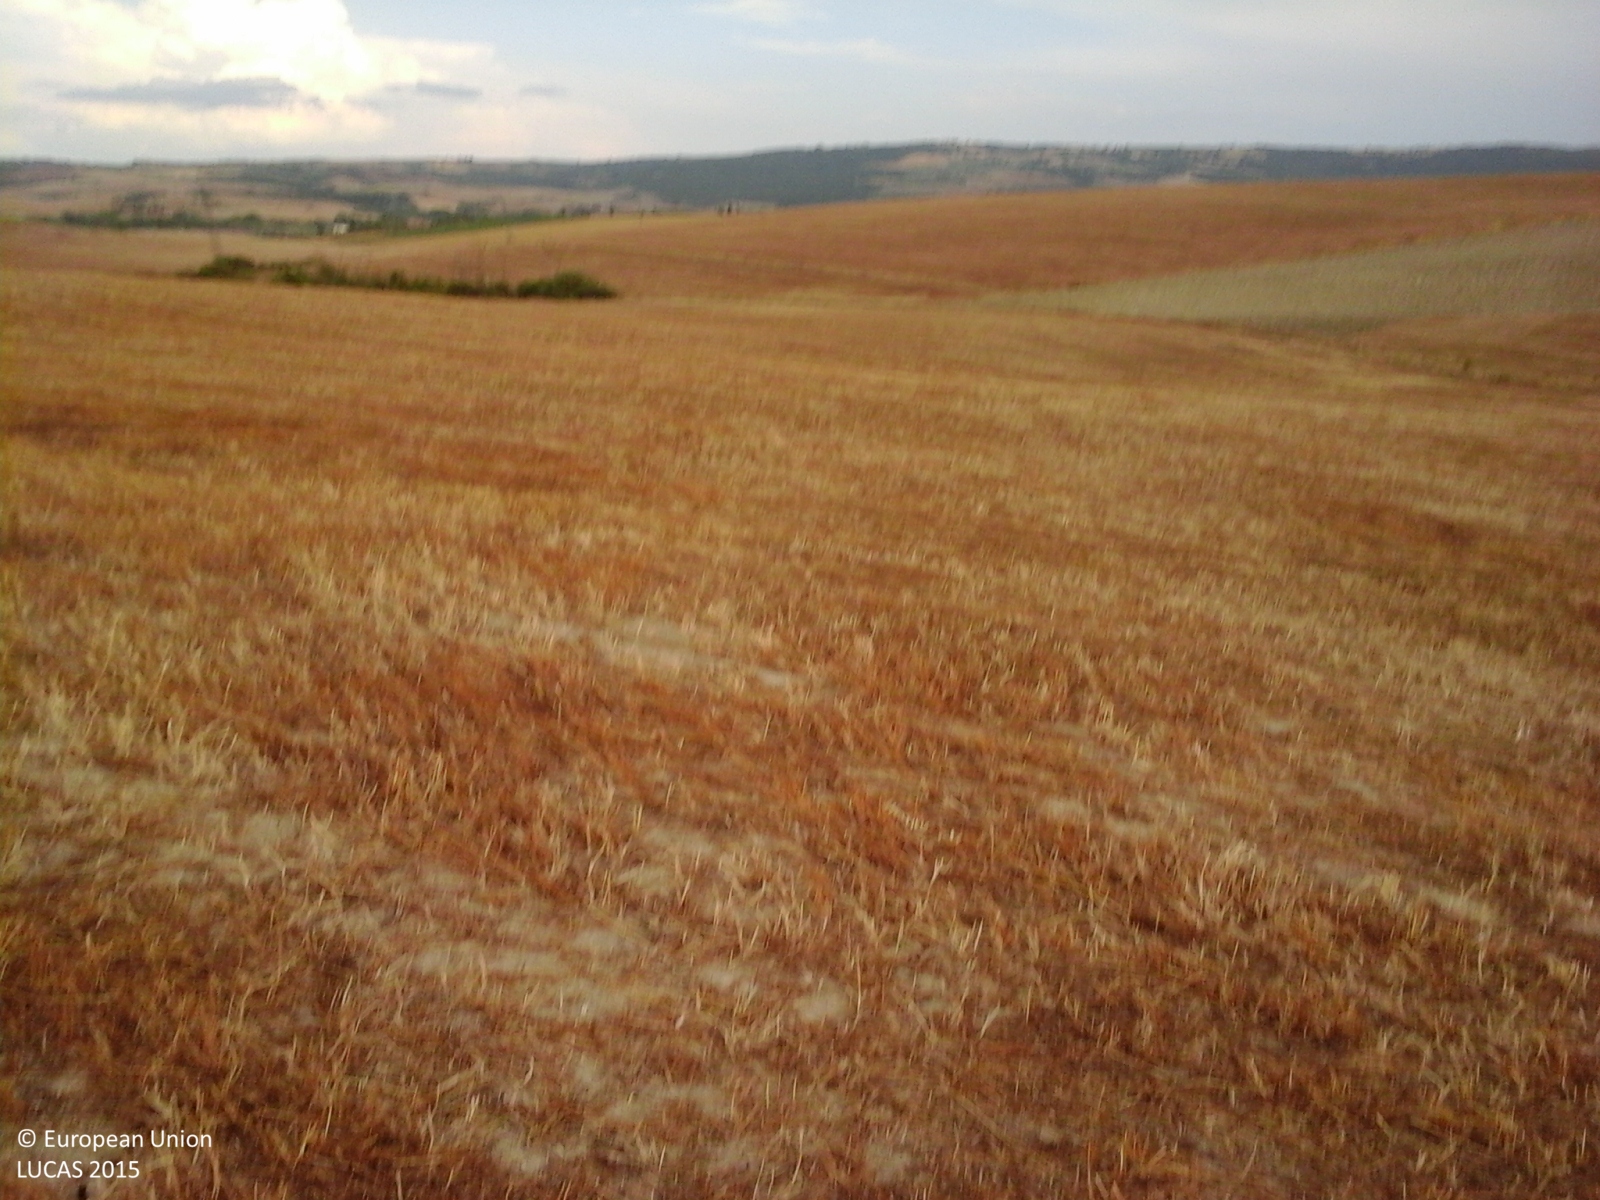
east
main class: Cropland
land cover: Temporary grasslands
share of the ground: > 75 %
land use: Agriculture (excluding fallow land and kitchen gardens)
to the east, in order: Temporary grasslands
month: July
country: IT
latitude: 43.0579
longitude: 11.5301
